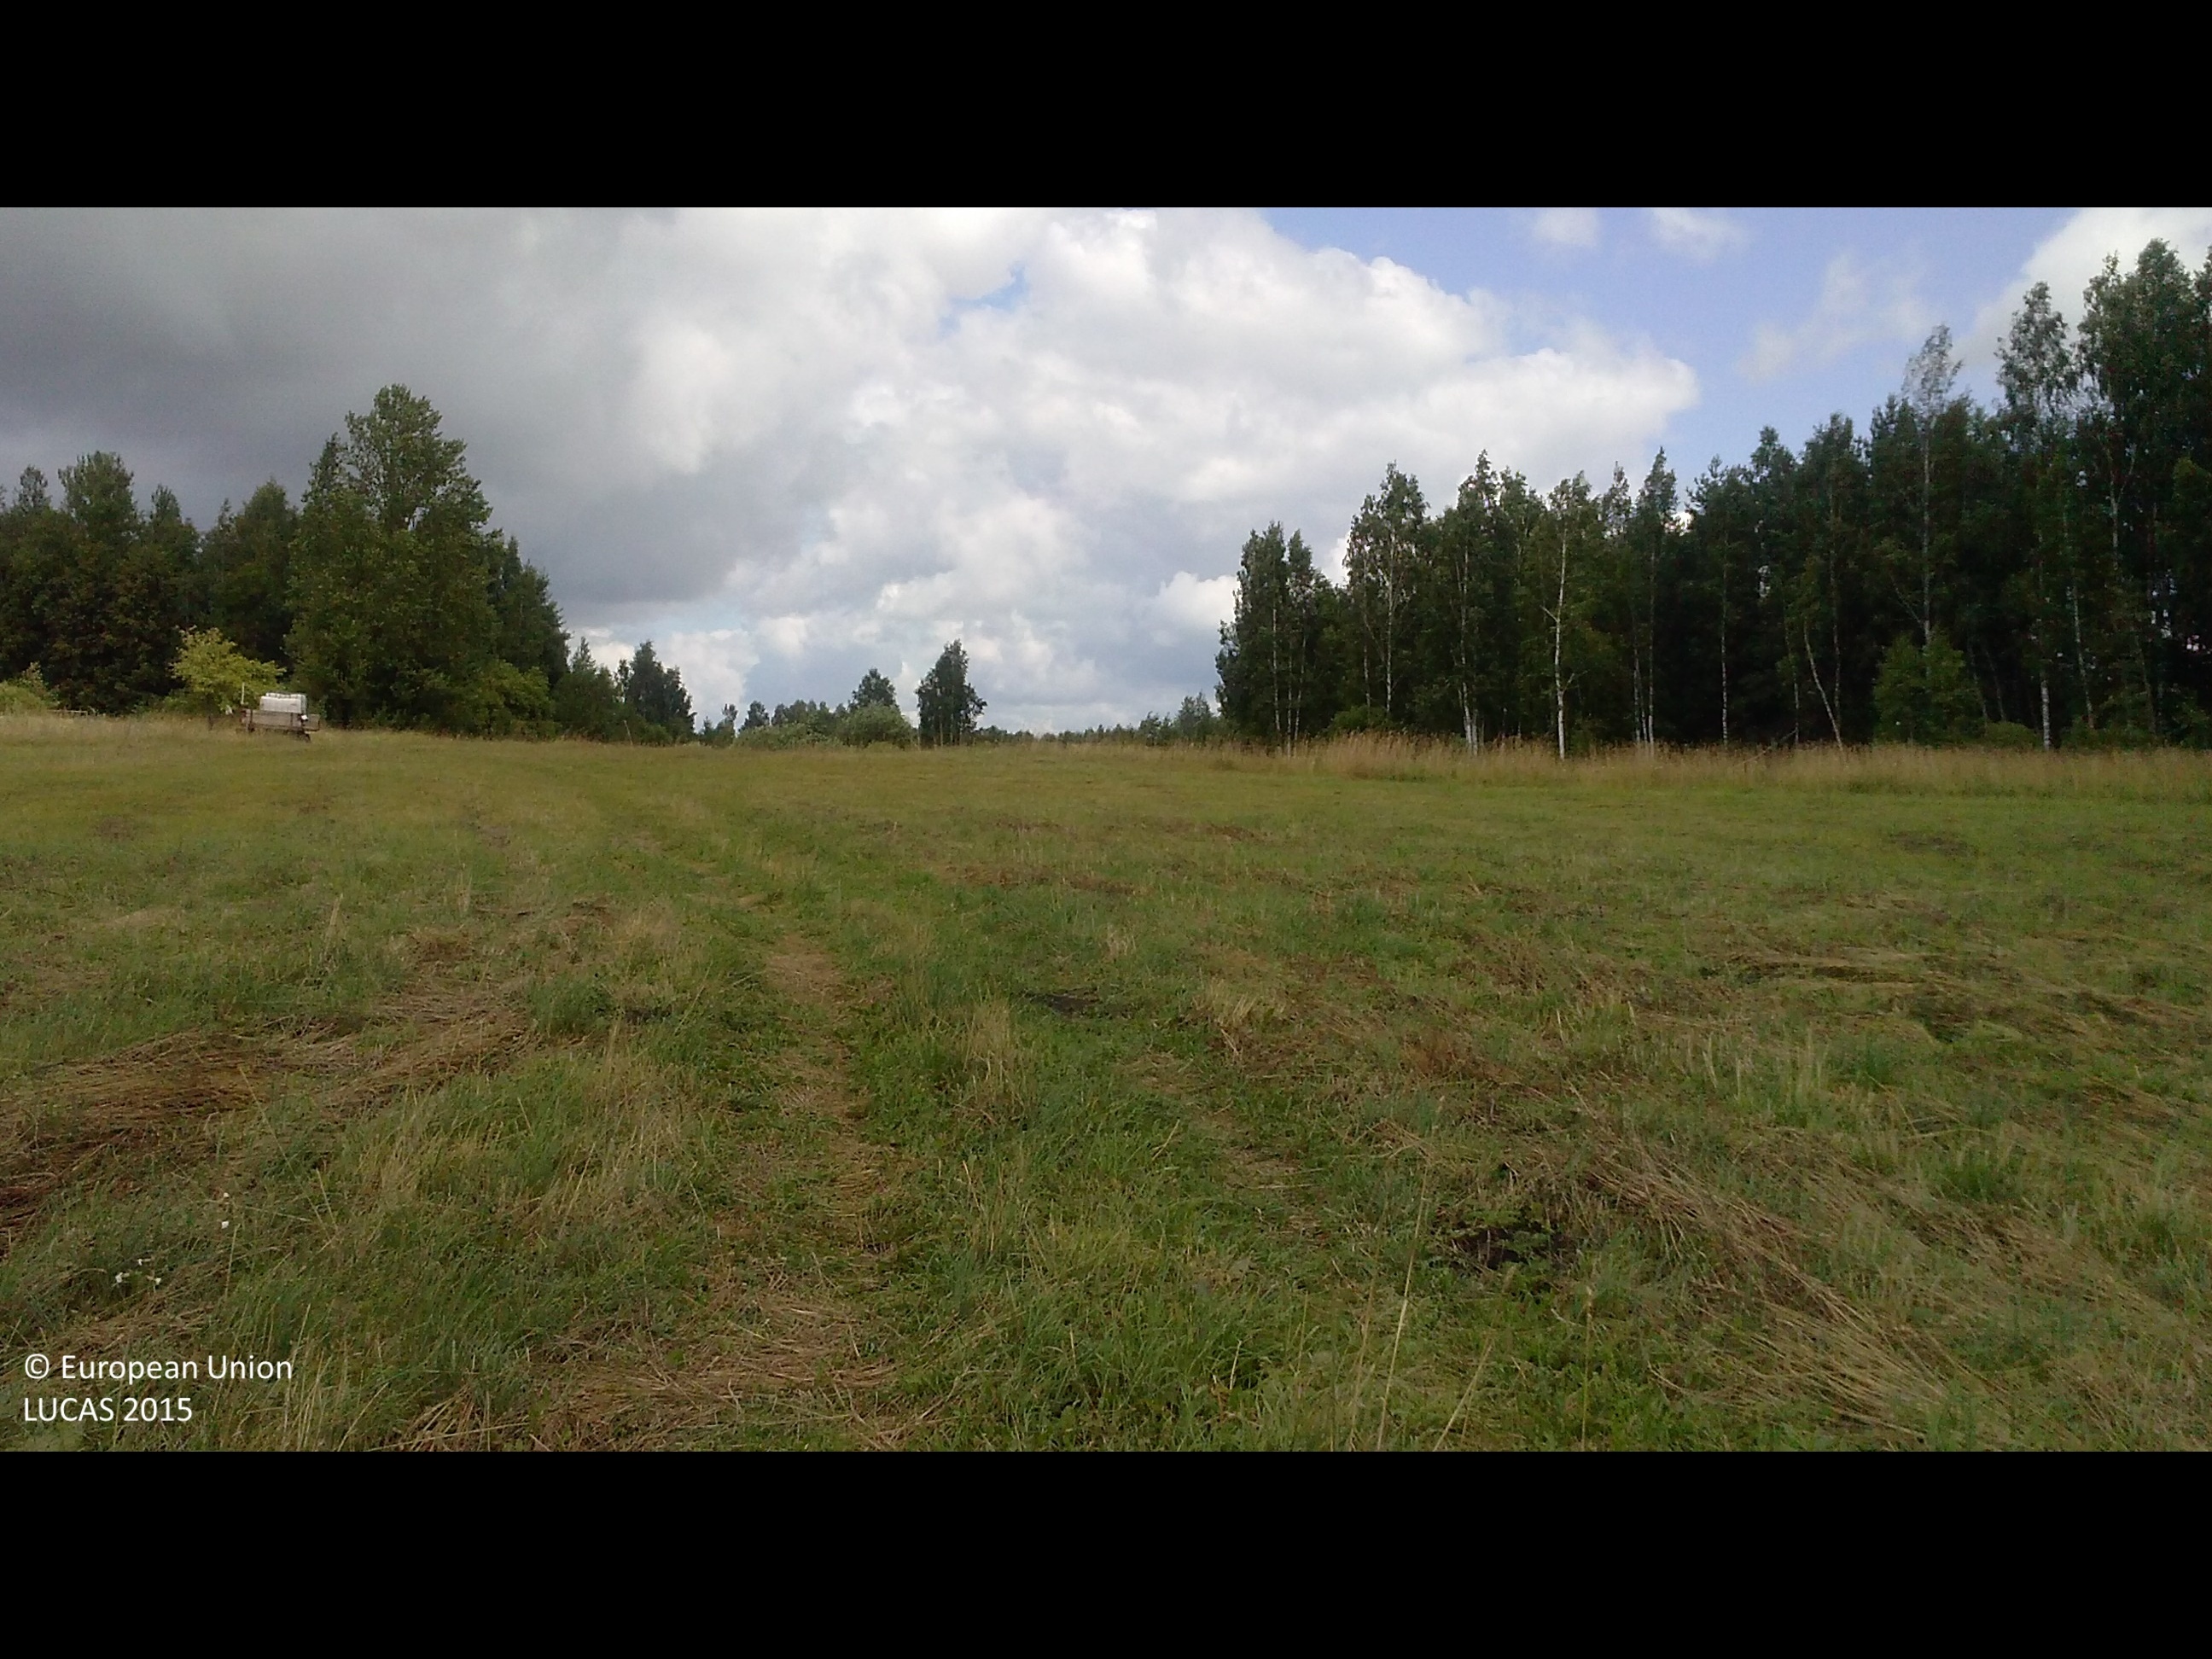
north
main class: Grassland
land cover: Grassland without tree/shrub cover
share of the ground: > 75 %
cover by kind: herbaceous plants 95 %, unconsolidated bare surface 5 %
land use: Agriculture (excluding fallow land and kitchen gardens)
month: July
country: LV
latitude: 56.4781
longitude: 26.9999
